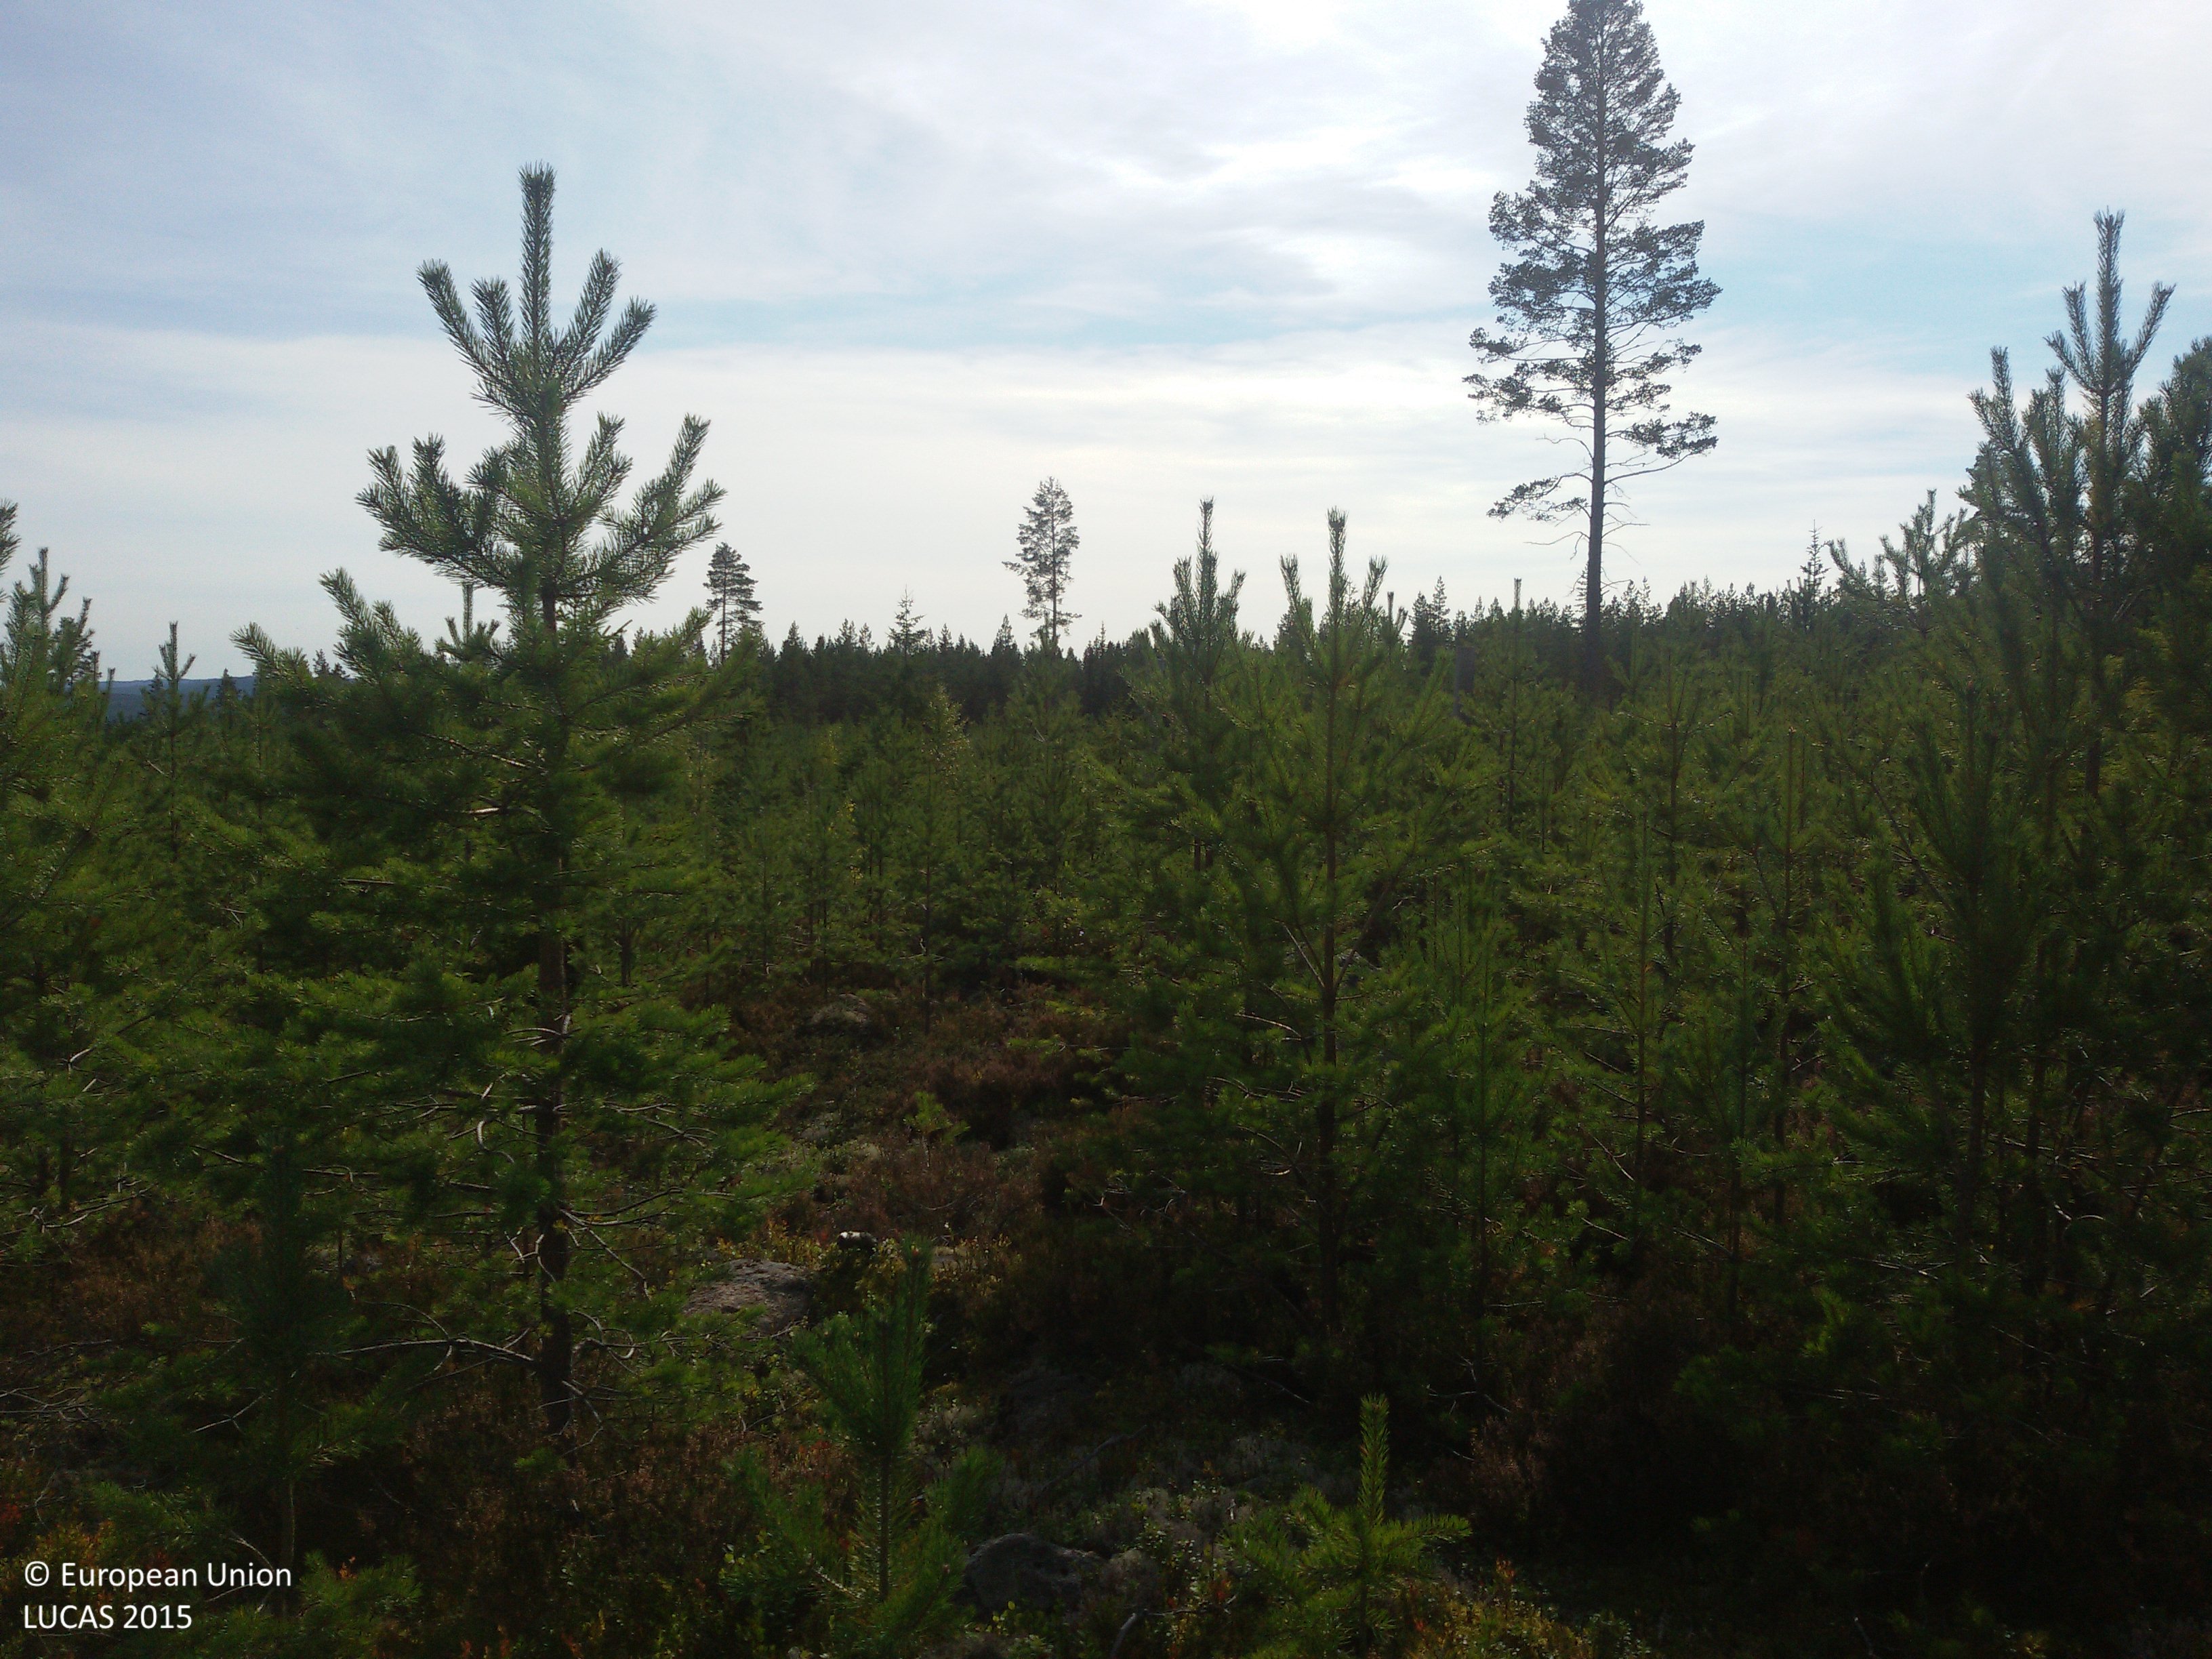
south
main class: Woodland
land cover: Pine dominated coniferous woodland
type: boreal forest
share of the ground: 50 - 75 %
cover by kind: coniferous forest trees 70 %, lichens and mosses 15 %, shrubs 10 %, herbaceous plants 5 %
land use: Forestry
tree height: < 5 m
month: September
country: SE
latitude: 61.0185
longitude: 15.3328
